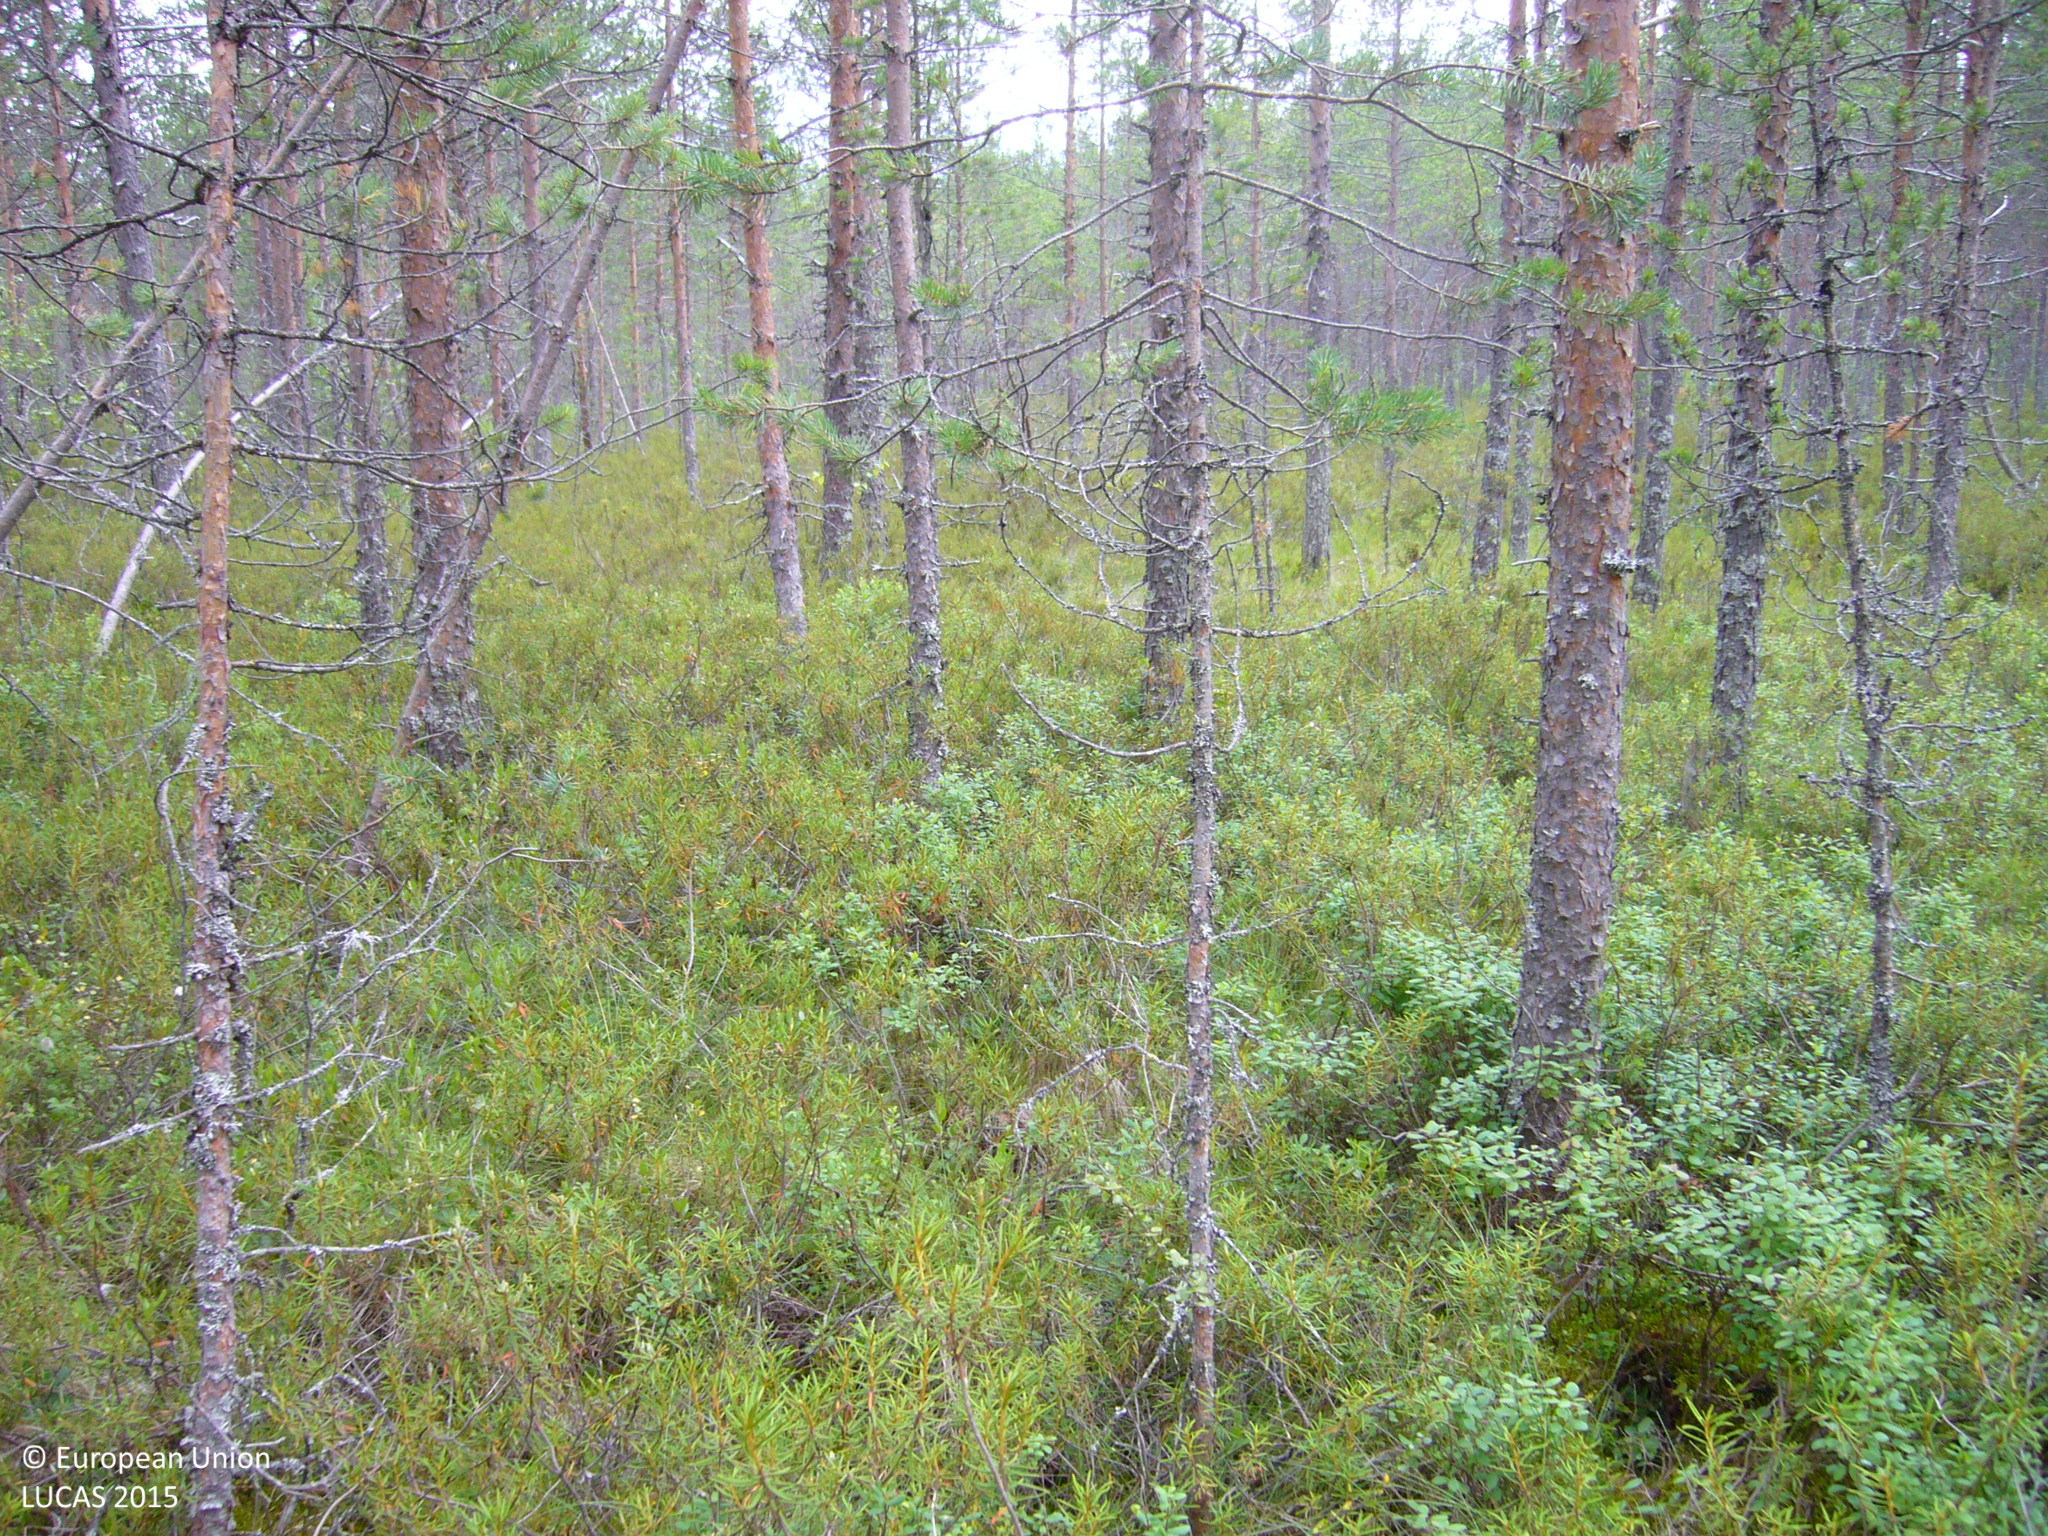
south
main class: Woodland
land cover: Pine dominated coniferous woodland
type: boreal forest
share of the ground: 50 - 75 %
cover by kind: coniferous forest trees 60 %, shrubs 40 %
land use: Forestry
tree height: > 5 m
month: July
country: FI
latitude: 64.0629
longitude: 26.3244
